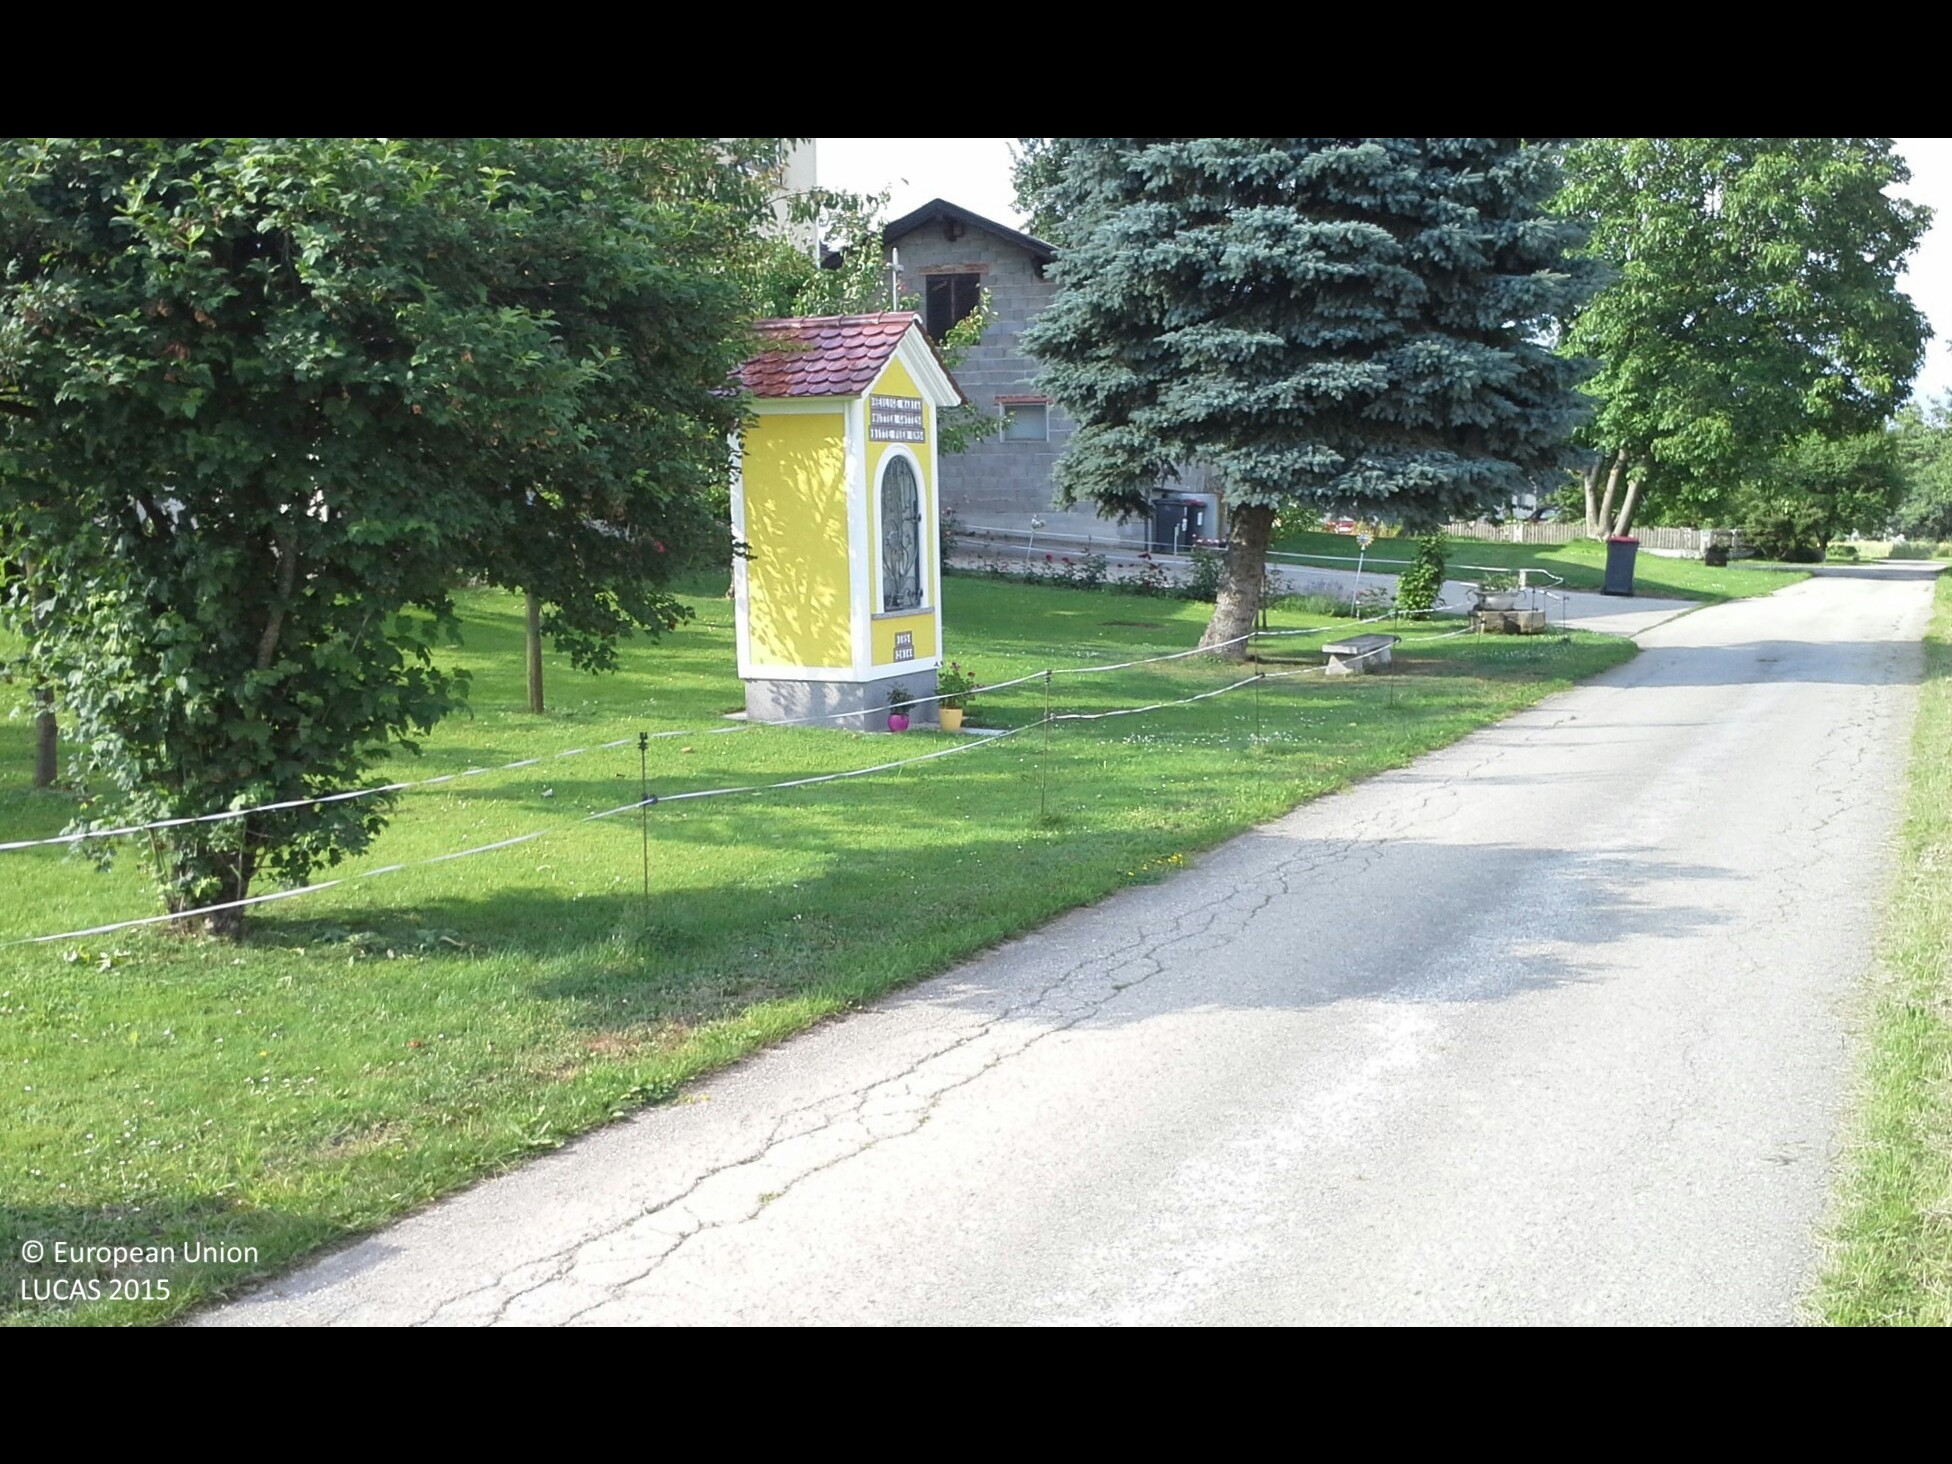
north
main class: Cropland
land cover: Common wheat
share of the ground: > 75 %
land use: Agriculture (excluding fallow land and kitchen gardens)
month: June
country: AT
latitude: 48.0509
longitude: 14.7093
